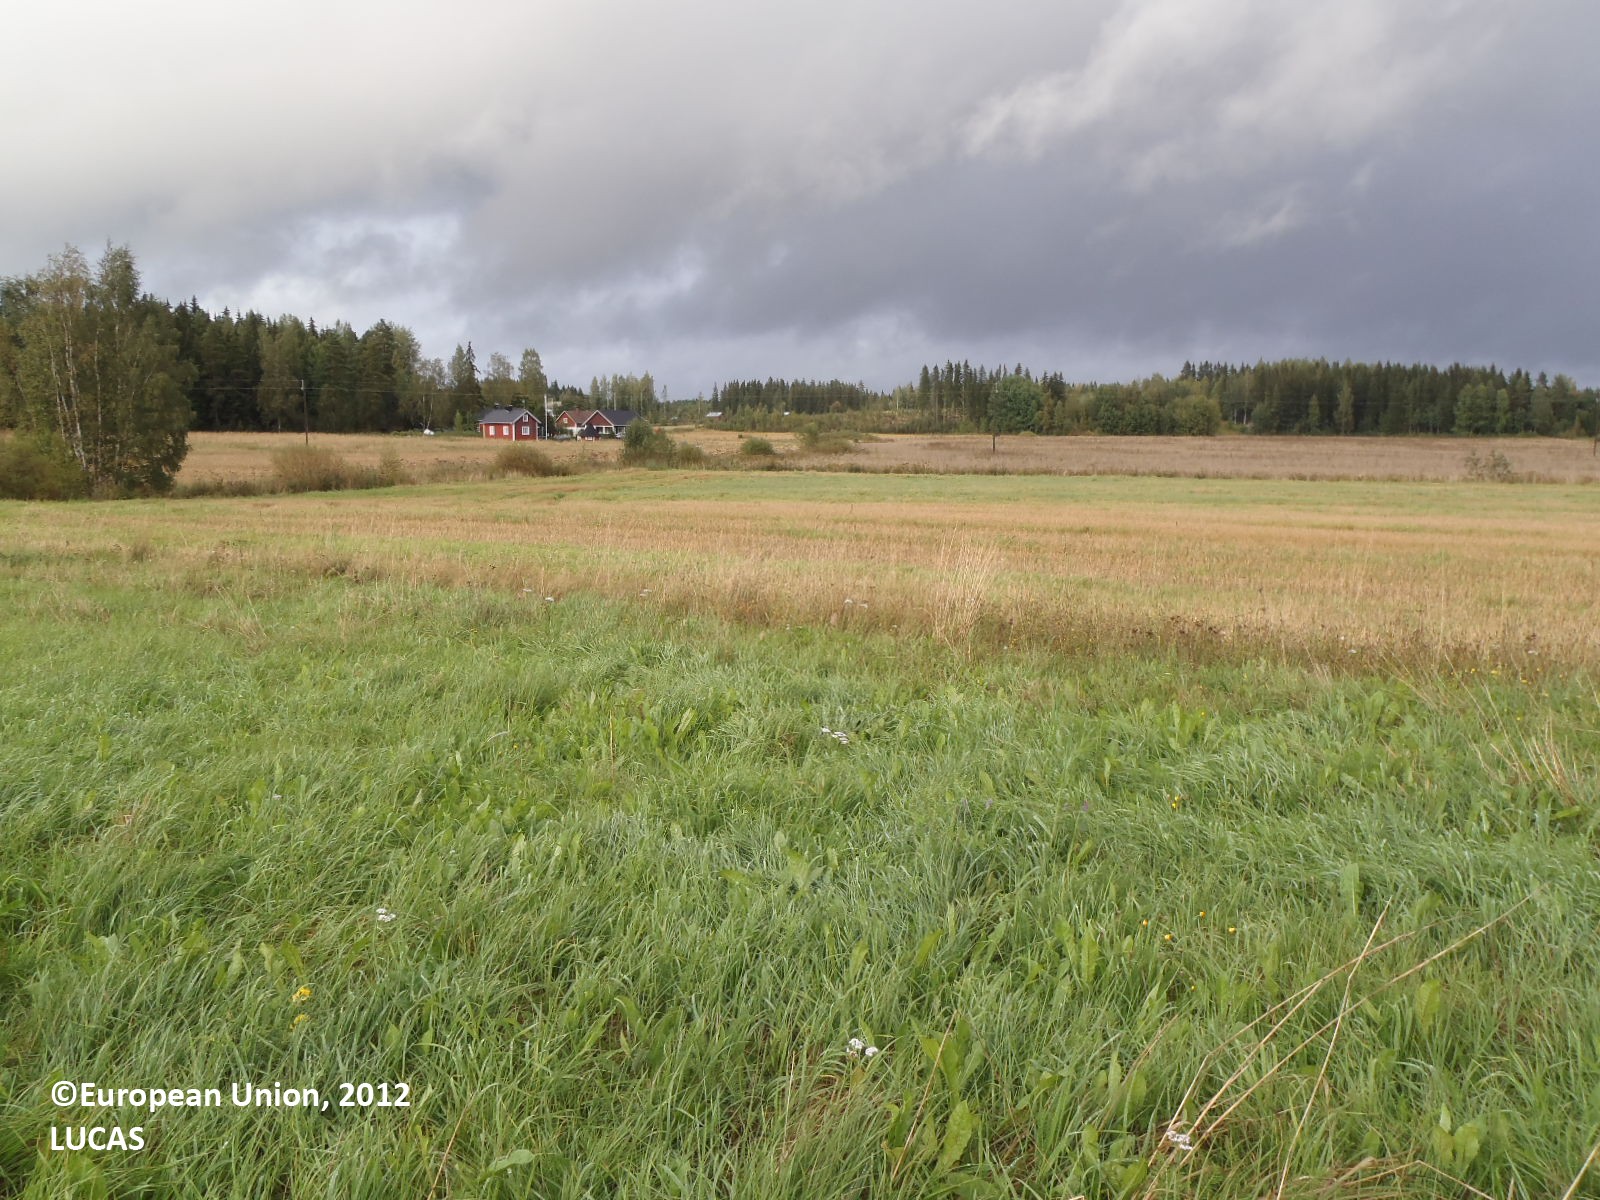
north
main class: Grassland
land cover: Grassland without tree/shrub cover
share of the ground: > 75 %
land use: Agriculture (excluding fallow land and kitchen gardens)
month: September
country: FI
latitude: 61.6113
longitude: 22.5255
